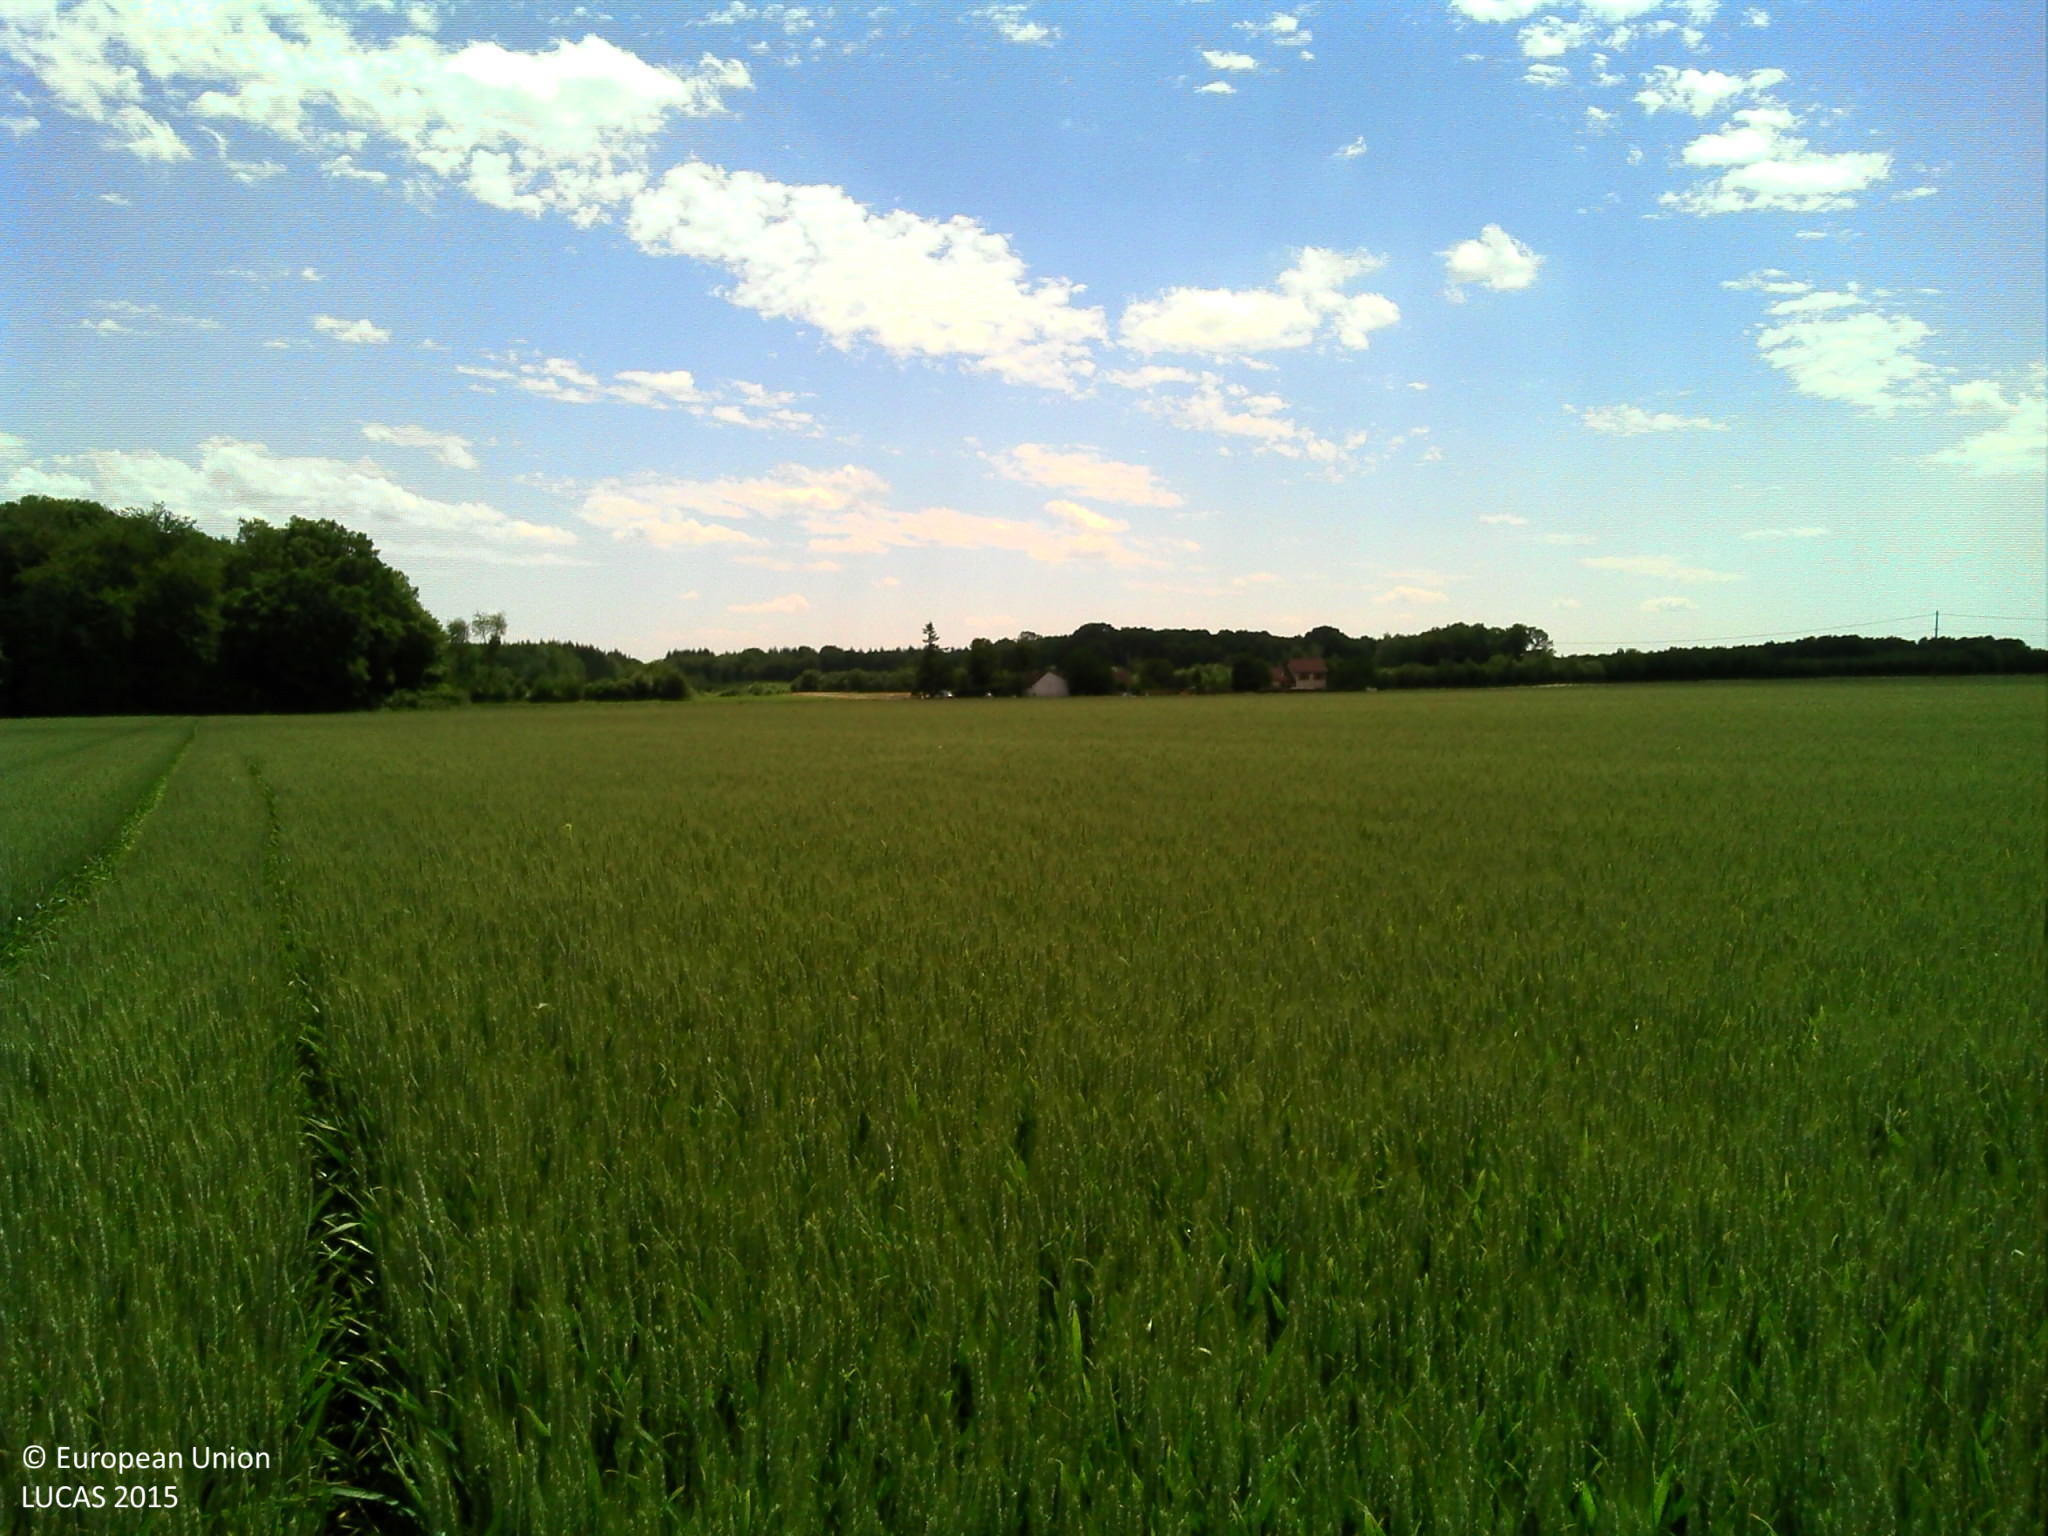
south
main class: Cropland
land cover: Common wheat
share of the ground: > 75 %
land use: Agriculture (excluding fallow land and kitchen gardens)
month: May
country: FR
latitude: 47.2561
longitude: 5.2570
